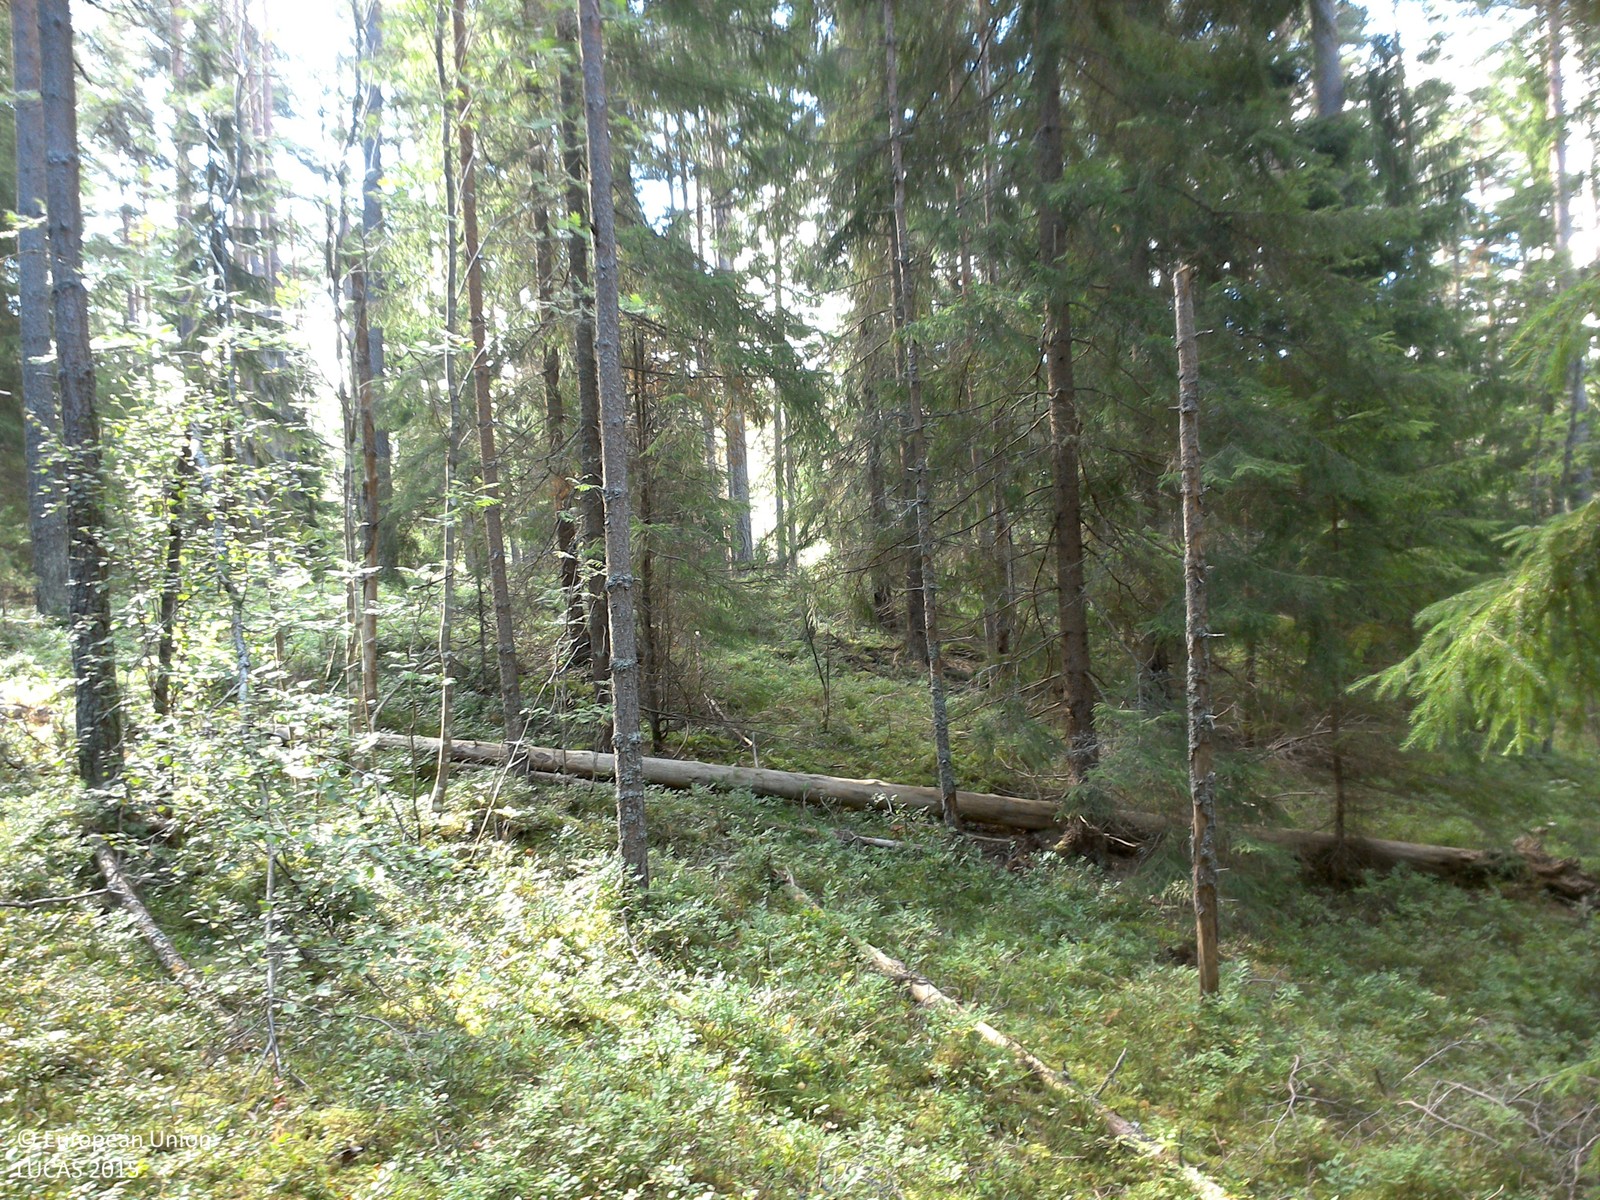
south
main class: Woodland
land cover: Spruce dominated coniferous woodland
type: boreal forest
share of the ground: 25 - 50 %
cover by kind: coniferous forest trees 50 %, herbaceous plants 30 %, lichens and mosses 20 %
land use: Forestry
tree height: > 5 m
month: August
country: SE
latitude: 57.9010
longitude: 15.2428
